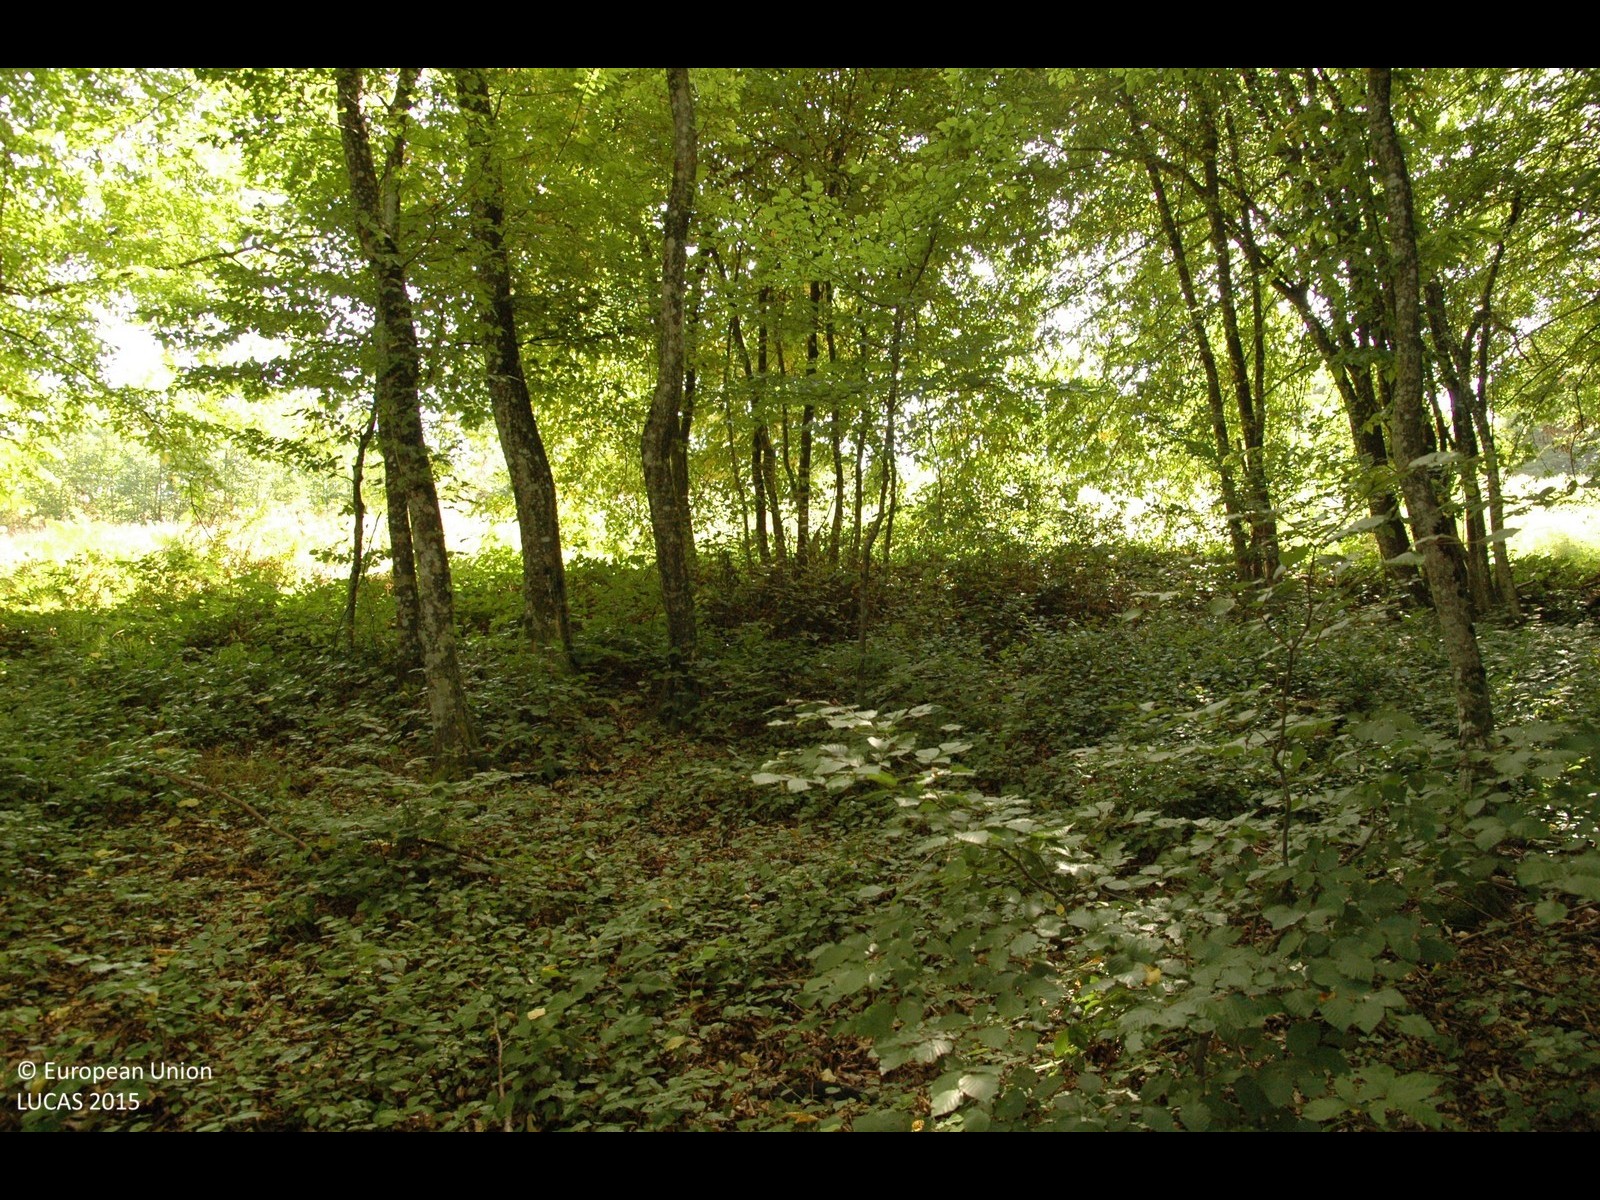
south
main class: Woodland
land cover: Broadleaved woodland
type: mesophytic deciduous forest
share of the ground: > 75 %
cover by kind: broadleaved forest trees 100 %
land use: Forestry
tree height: > 5 m
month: September
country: HR
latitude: 45.5740
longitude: 15.9045
